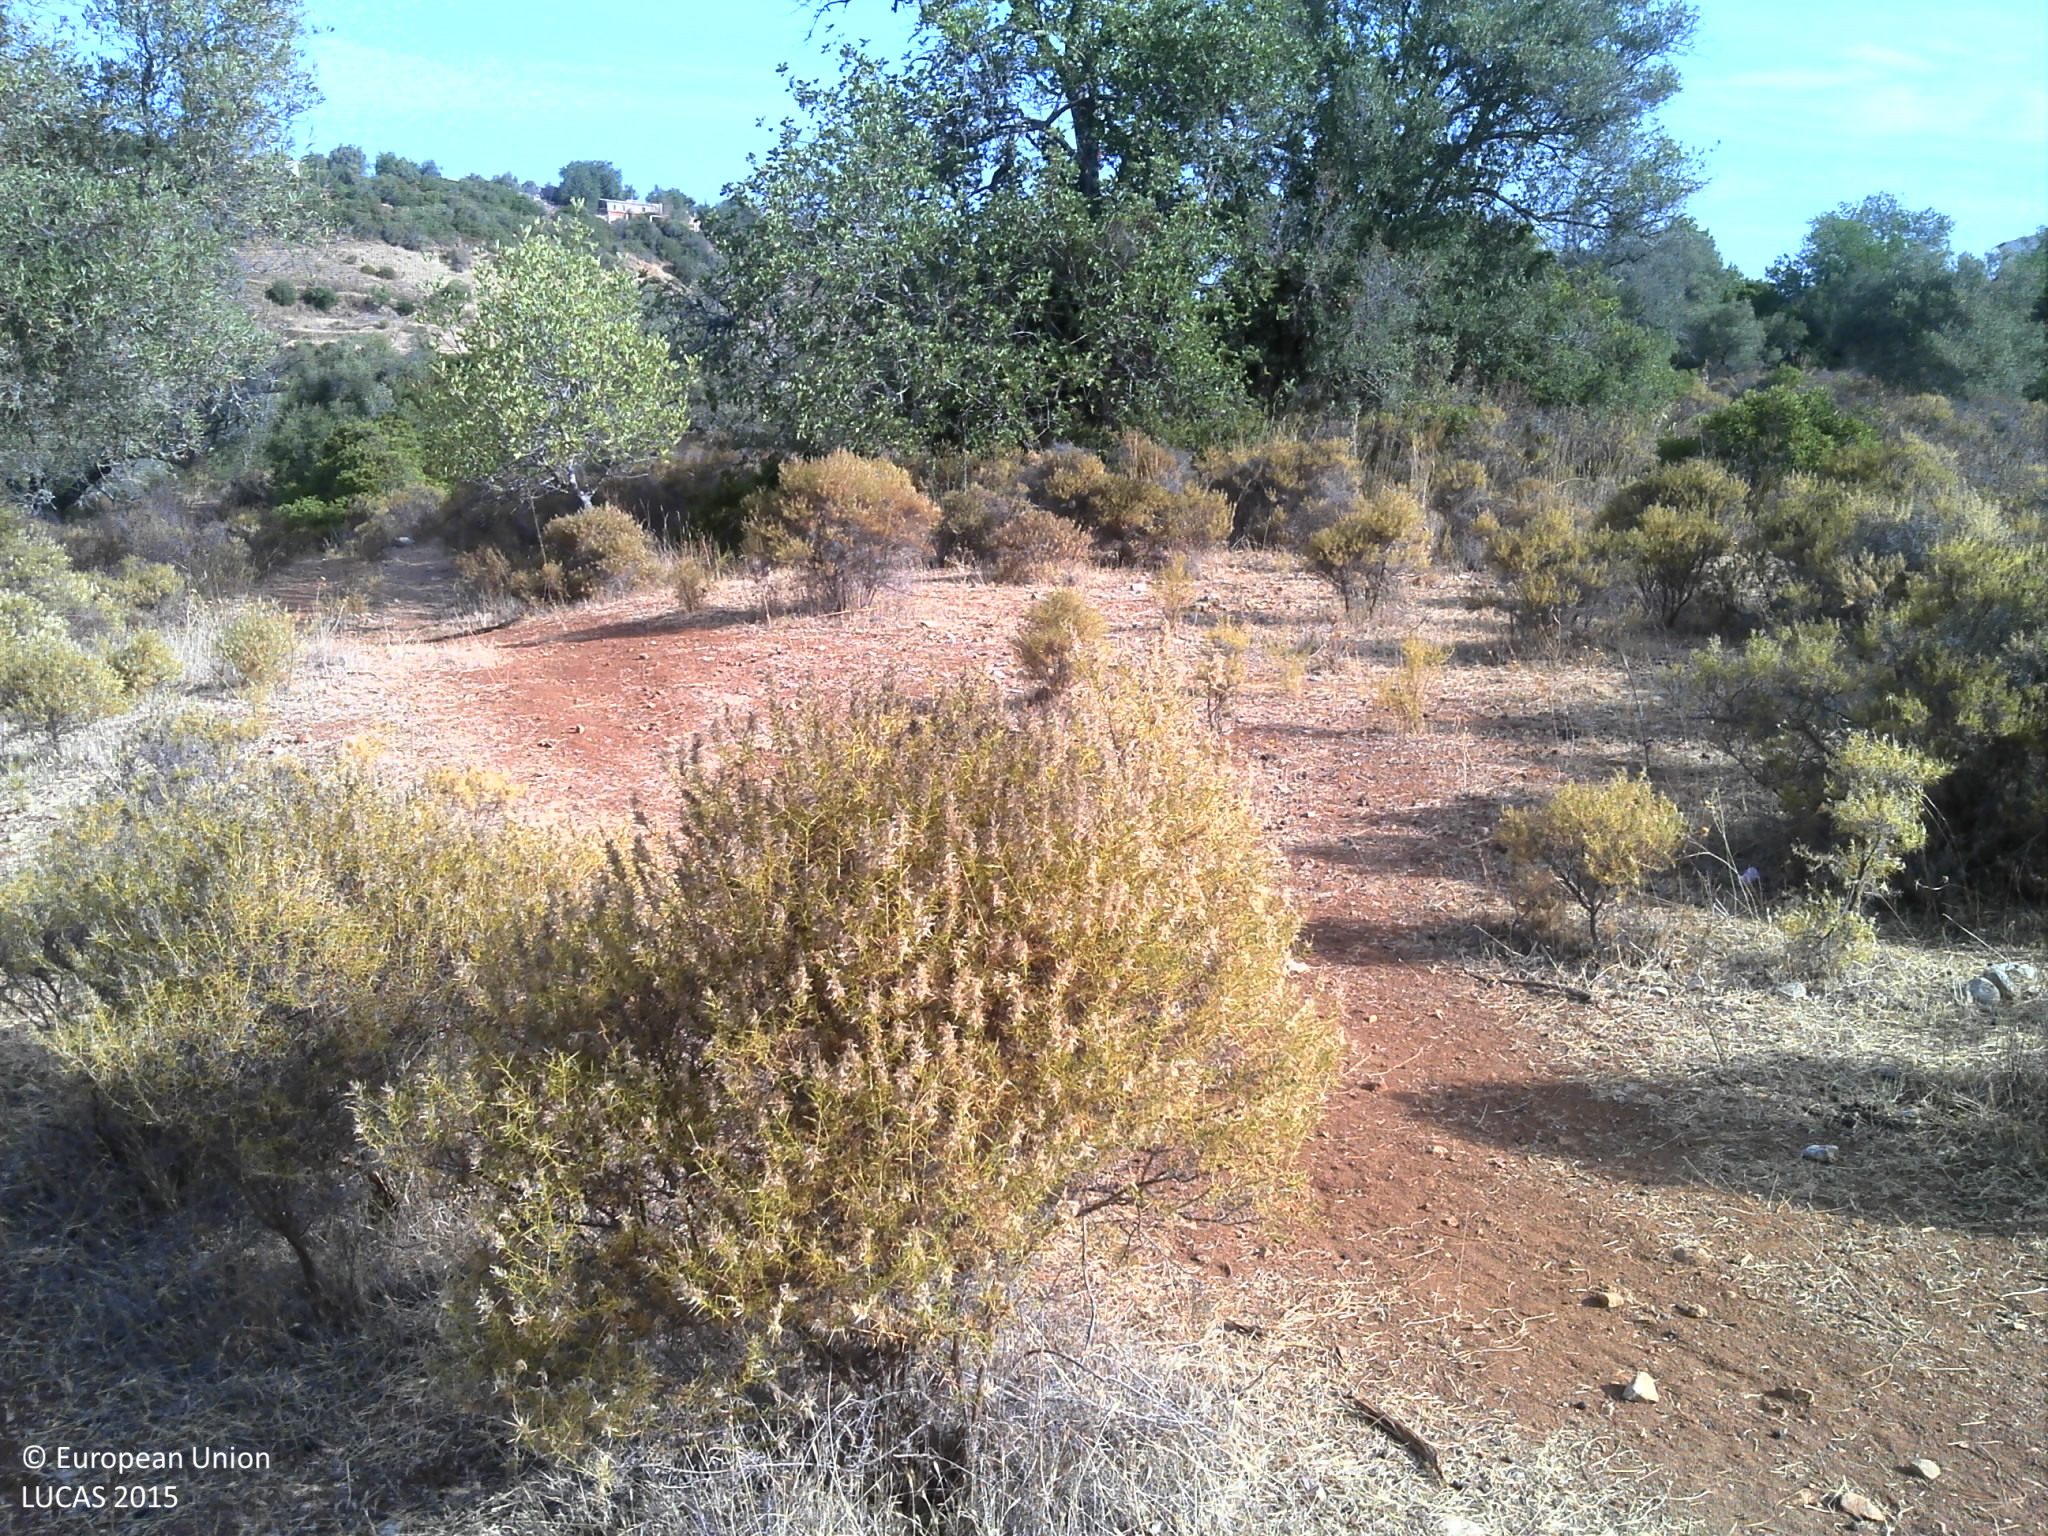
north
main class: Shrubland
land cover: Shrubland with sparse tree cover
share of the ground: 25 - 50 %
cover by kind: shrubs 40 %, unconsolidated bare surface 35 %, herbaceous plants 20 %, broadleaved forest trees 5 %
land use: Agriculture (excluding fallow land and kitchen gardens)
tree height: < 5 m
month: September
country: PT
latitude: 37.1432
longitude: -8.3839
